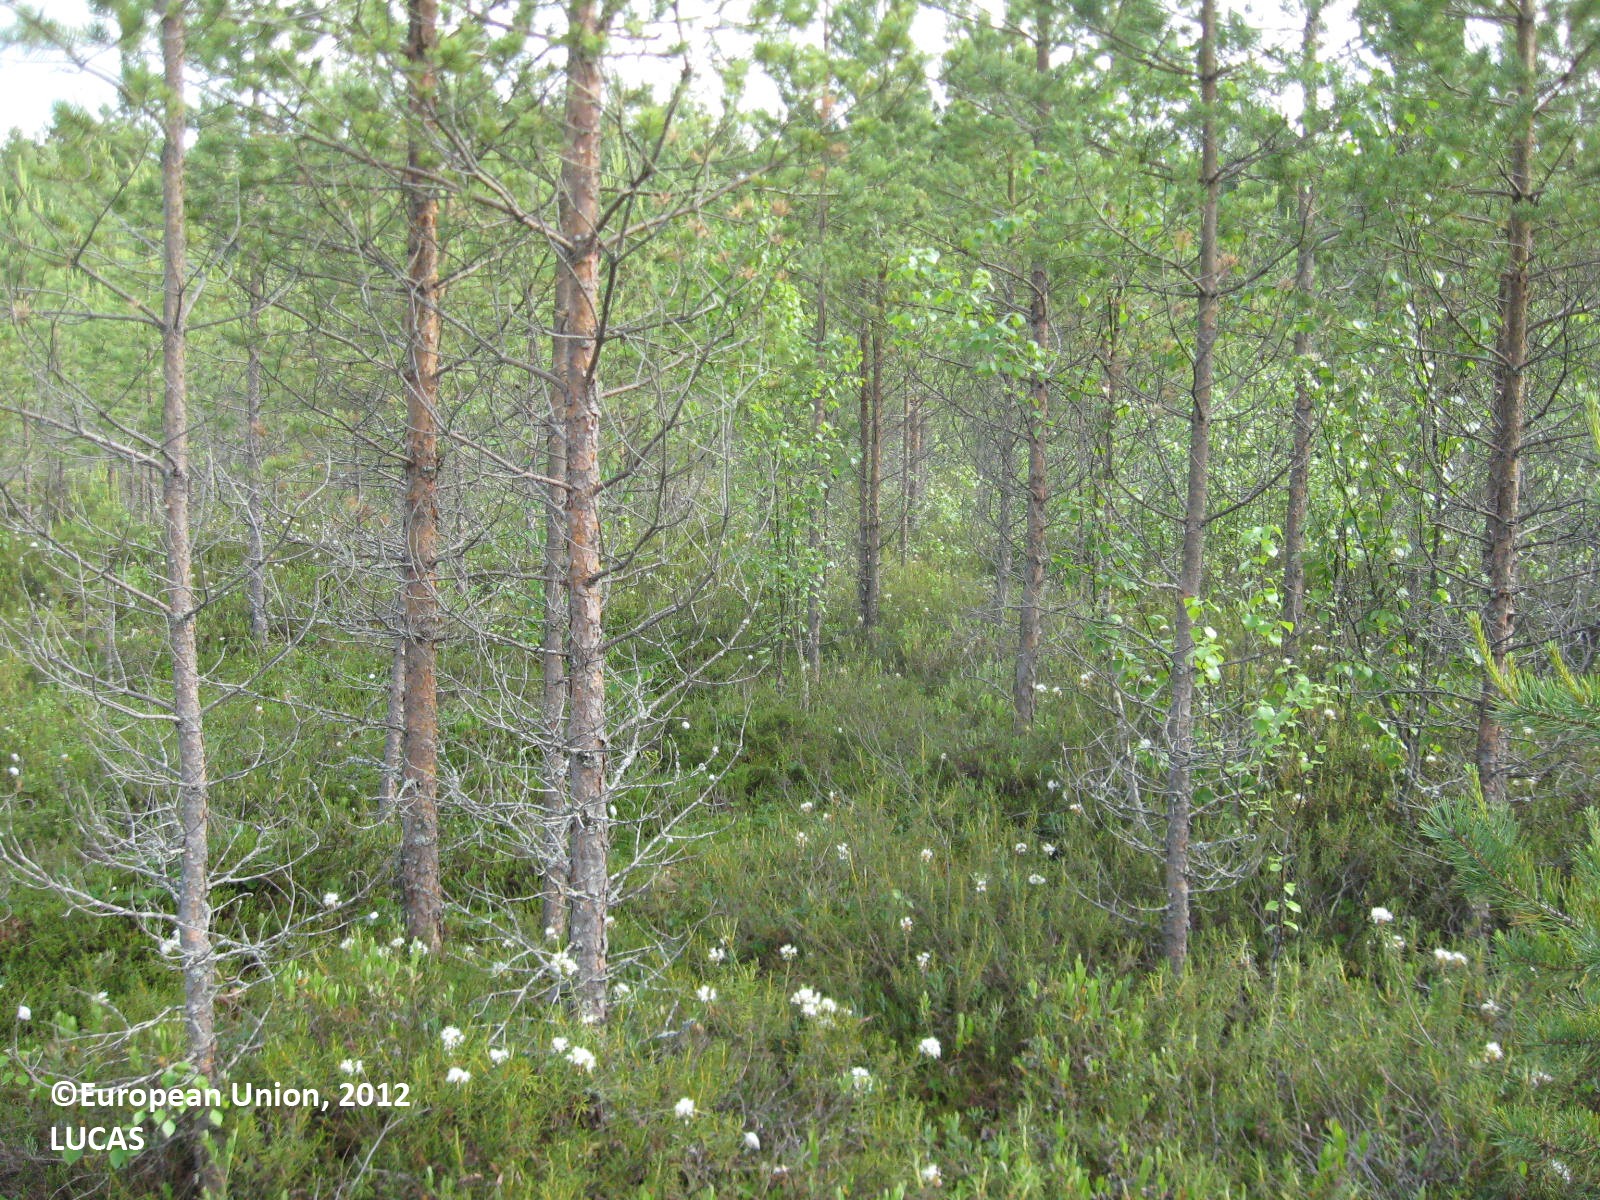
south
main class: Woodland
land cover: Pine dominated coniferous woodland
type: boreal forest
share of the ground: 50 - 75 %
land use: Forestry
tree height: > 5 m
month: June
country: FI
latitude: 63.0127
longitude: 22.8359
